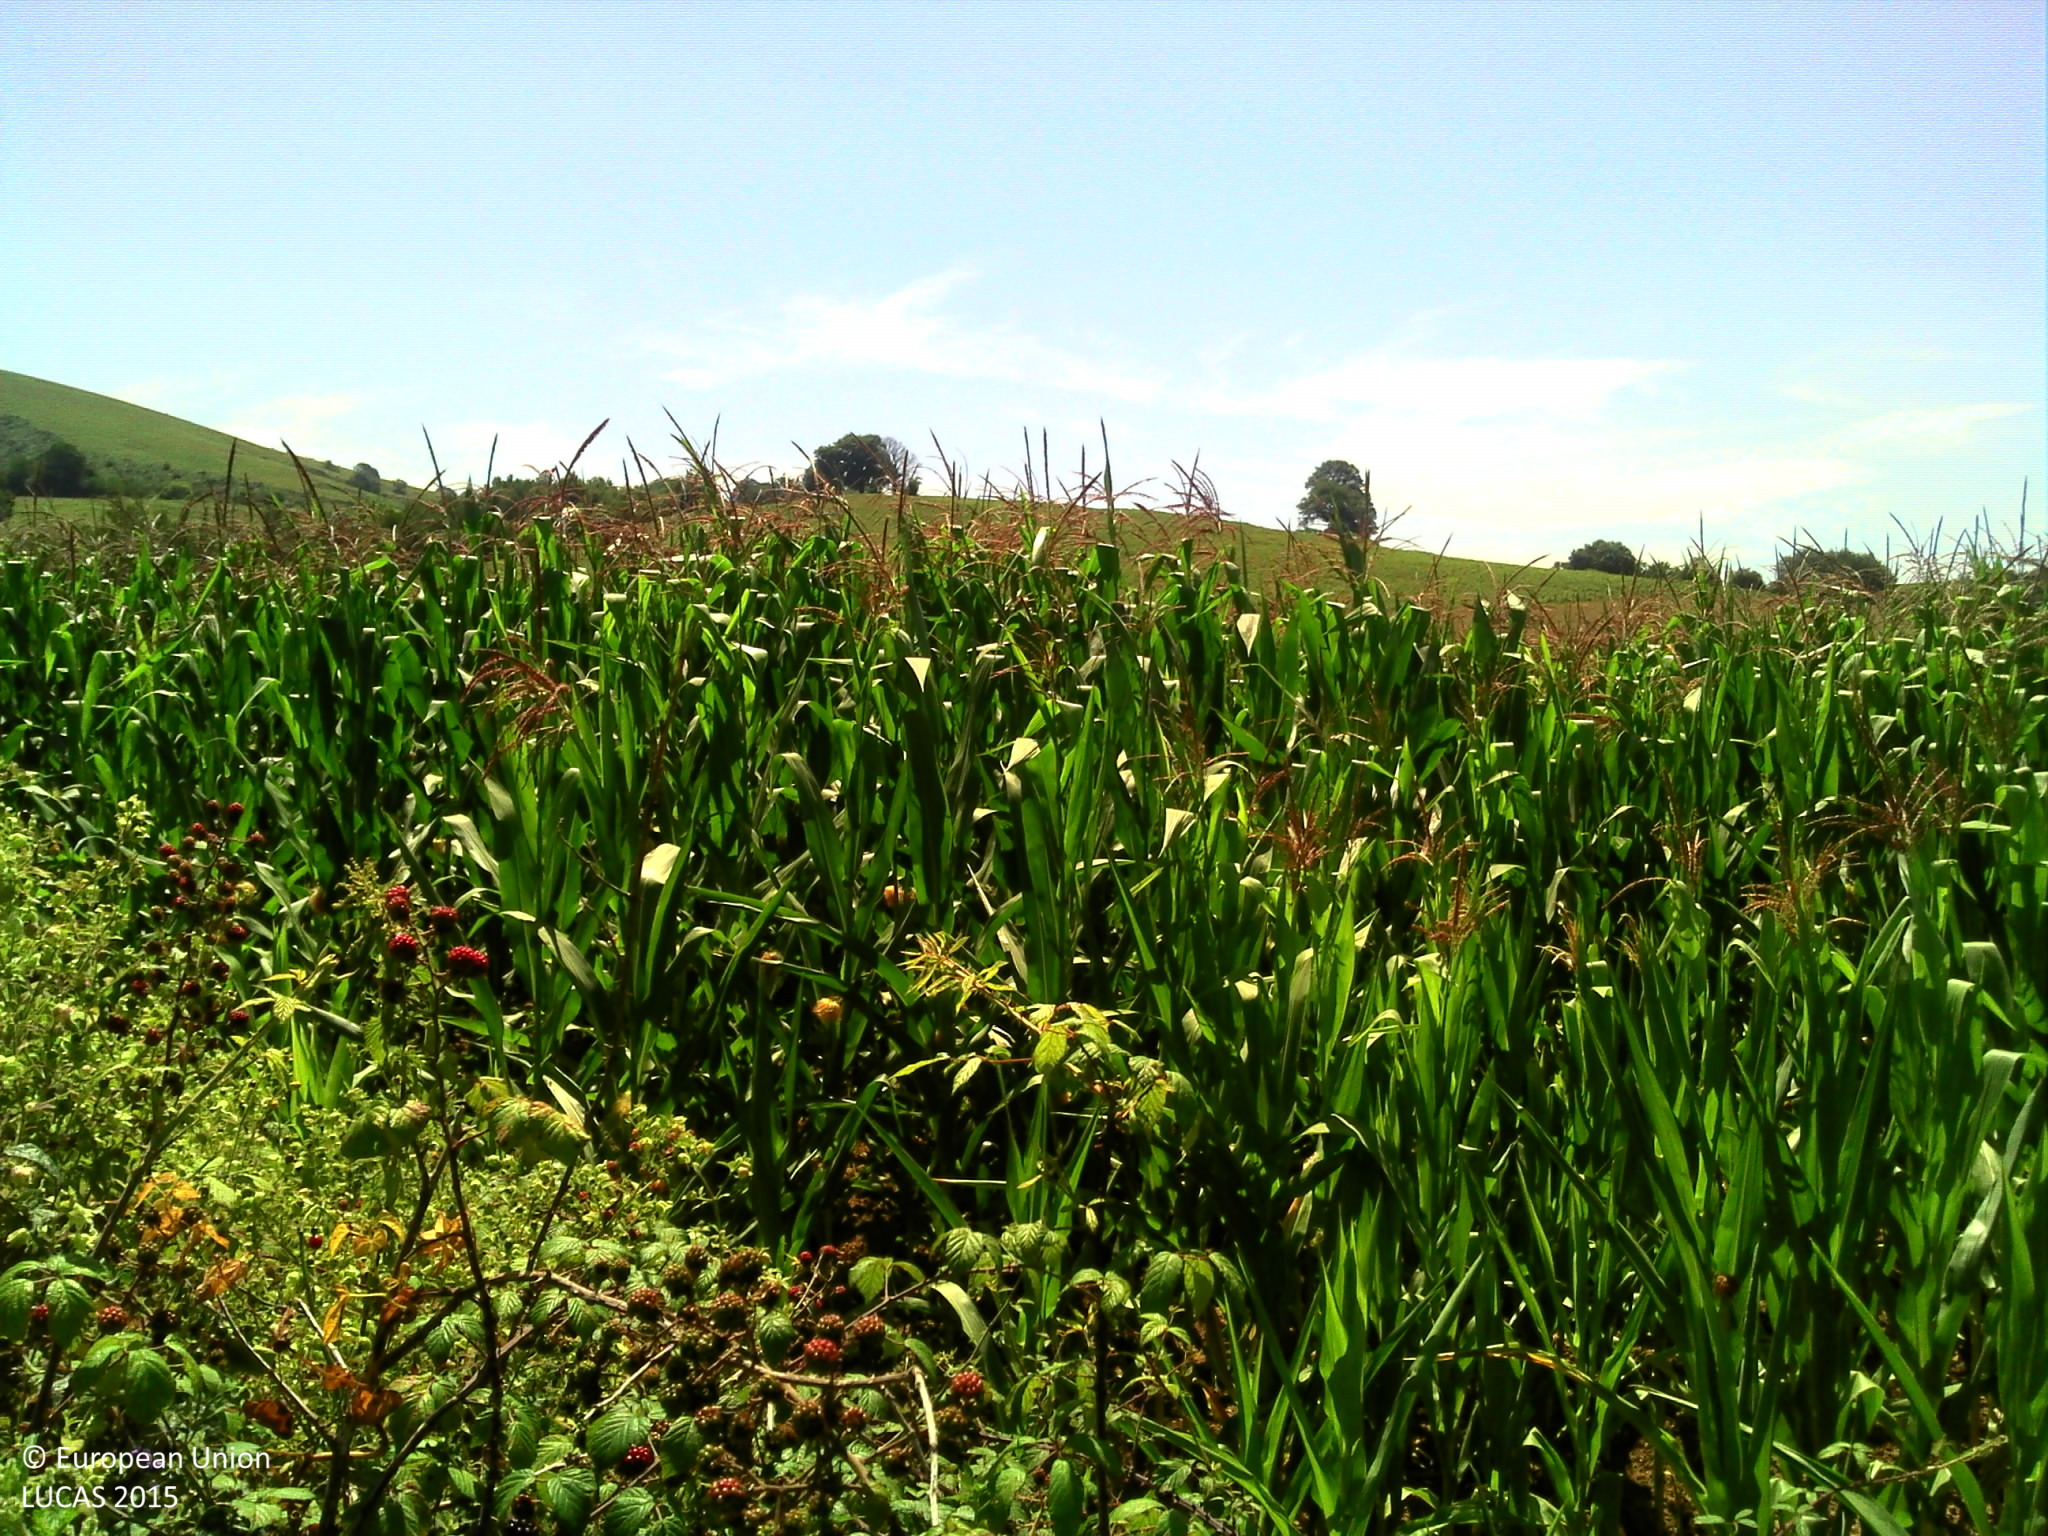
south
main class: Cropland
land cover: Maize
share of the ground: > 75 %
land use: Agriculture (excluding fallow land and kitchen gardens)
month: August
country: FR
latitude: 43.3113
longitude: -1.1469
